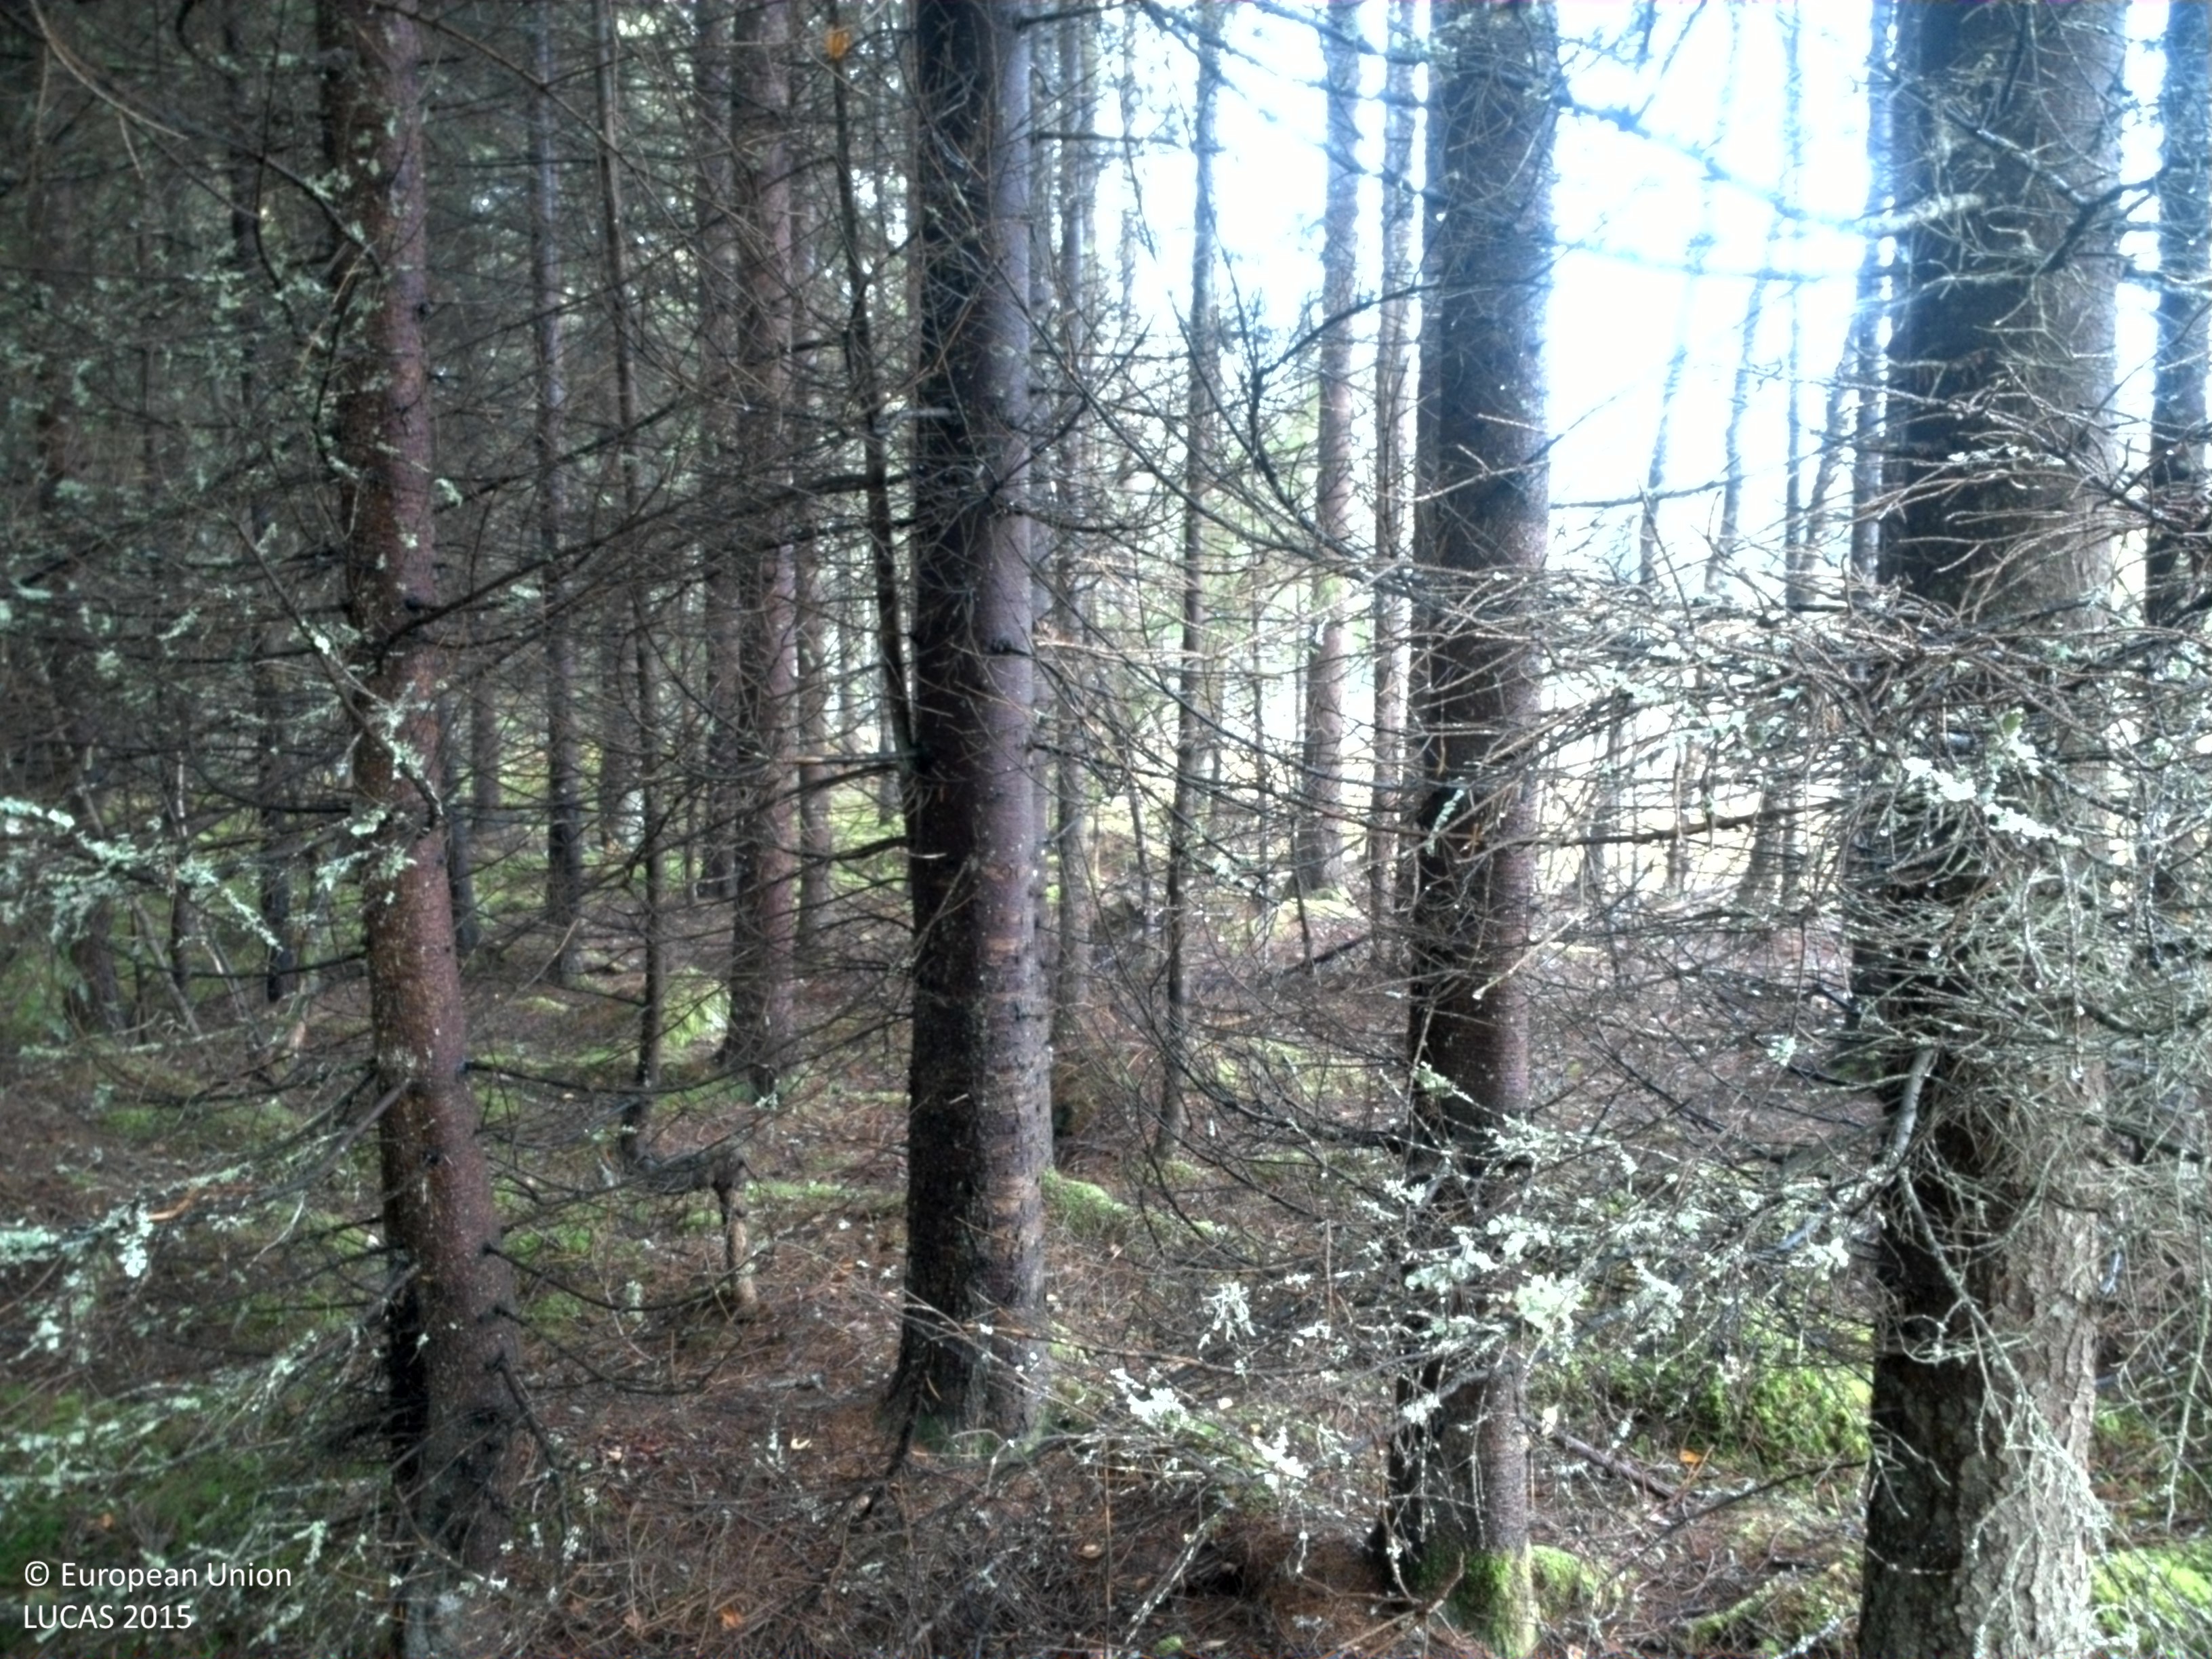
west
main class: Woodland
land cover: Spruce dominated mixed woodland
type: boreal forest
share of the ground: 50 - 75 %
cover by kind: coniferous forest trees 30 %, broadleaved forest trees 20 %, shrubs 20 %, lichens and mosses 20 %, herbaceous plants 10 %
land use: Forestry
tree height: > 5 m
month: September
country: SE
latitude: 58.9693
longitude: 14.0448
